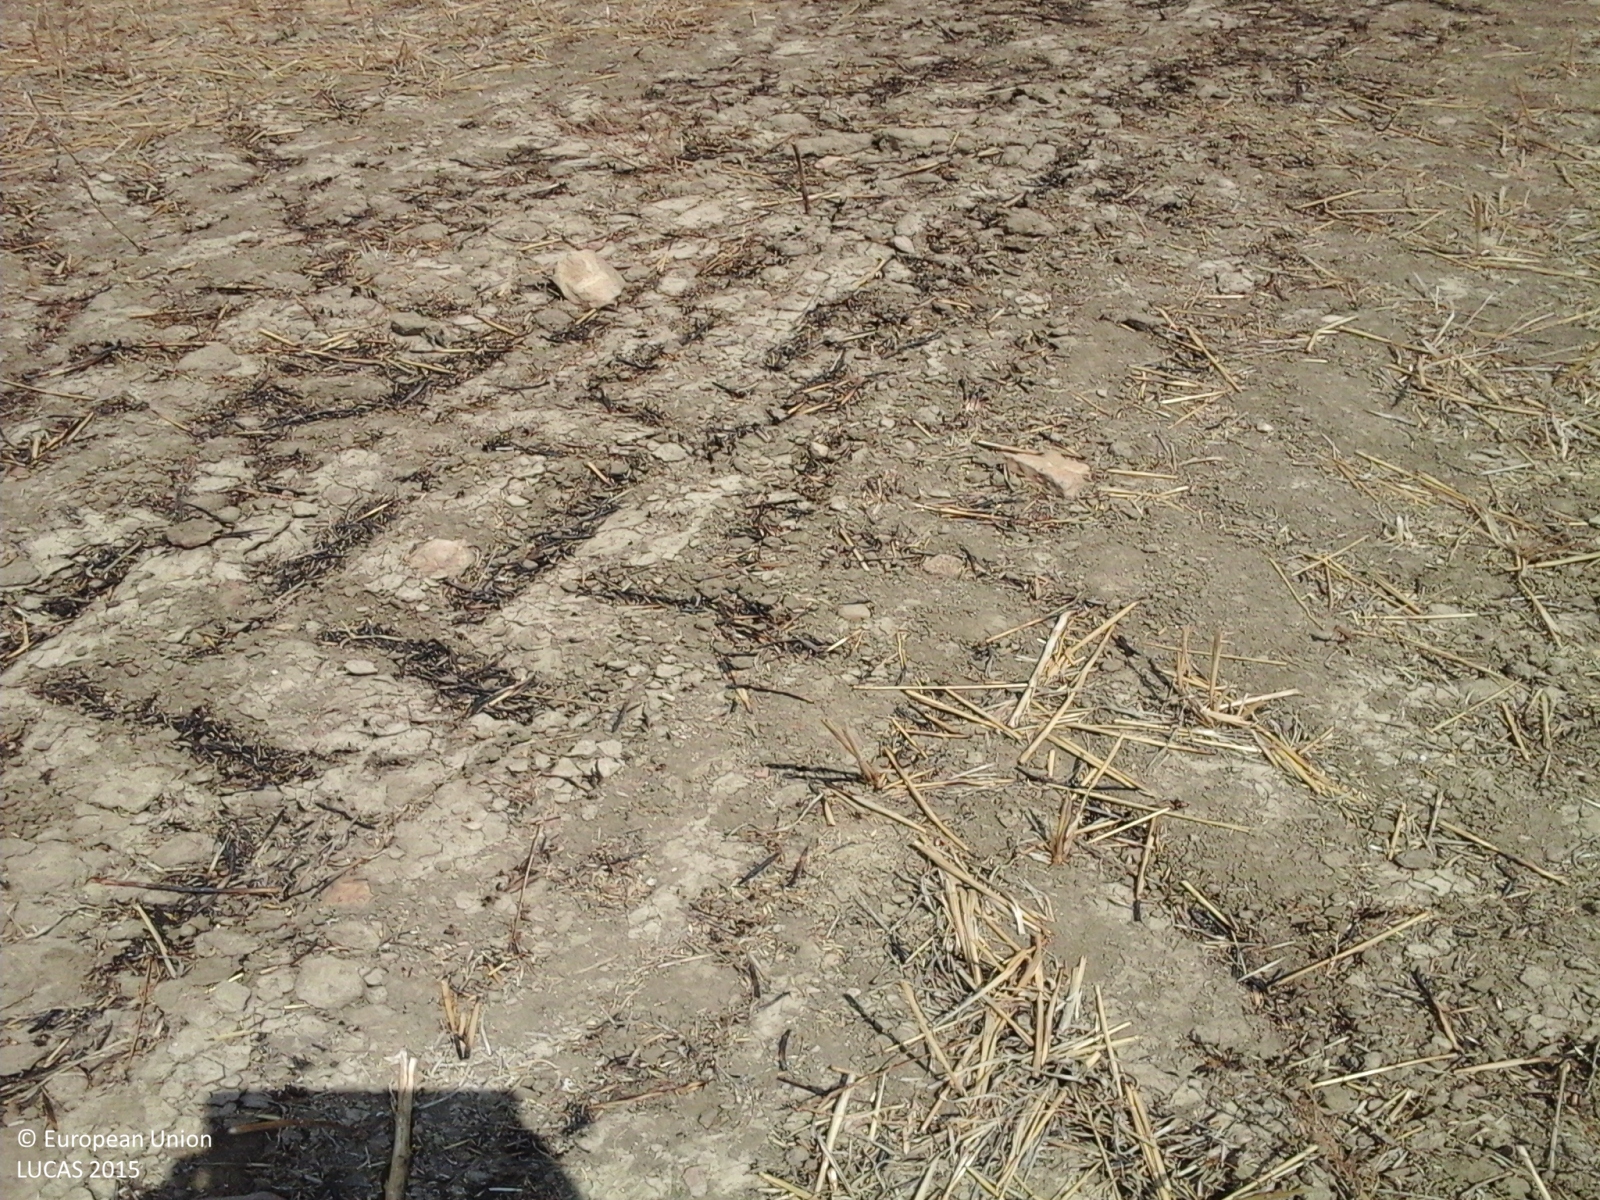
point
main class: Cropland
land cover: Durum wheat
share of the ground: > 75 %
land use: Agriculture (excluding fallow land and kitchen gardens)
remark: Burnt area
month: July
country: IT
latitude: 37.1562
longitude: 14.3687
